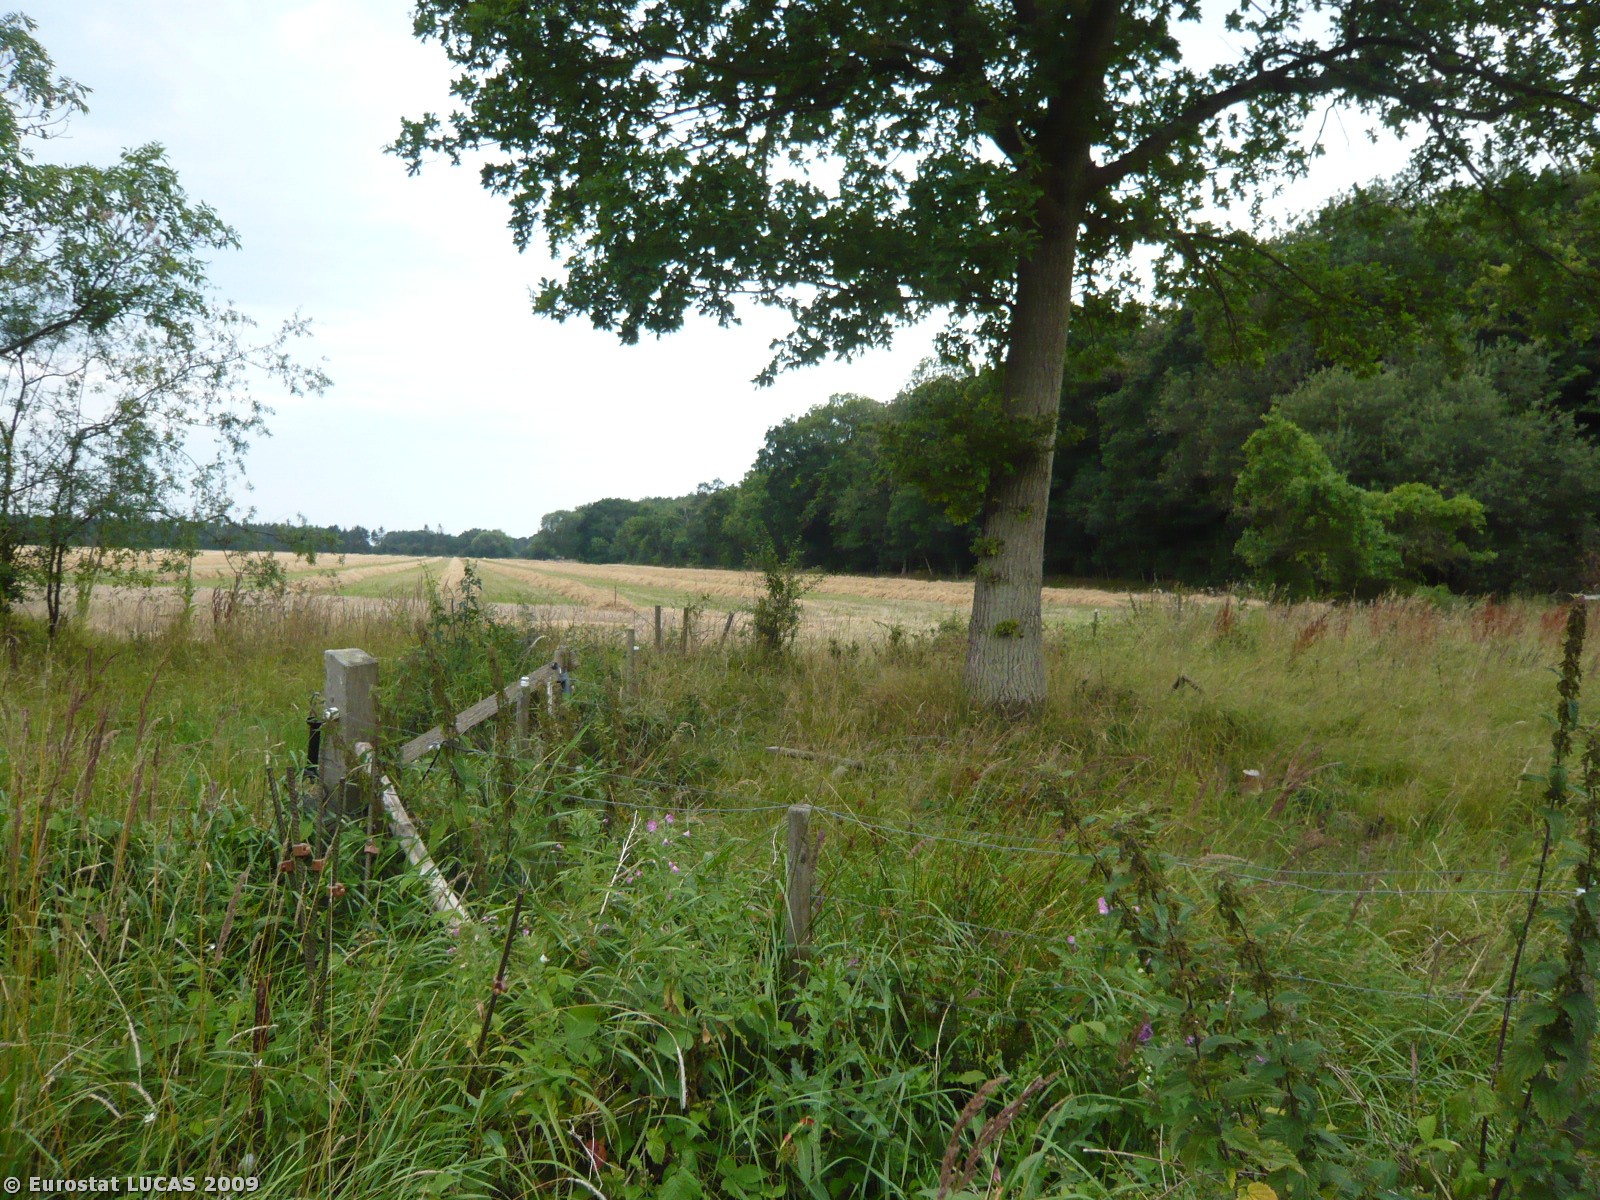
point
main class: Woodland
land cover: Broadleaved woodland
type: mesophytic deciduous forest
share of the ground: > 75 %
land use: Amenities, museums, leisure
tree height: > 5 m
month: August
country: DK
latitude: 55.9574
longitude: 11.9362
